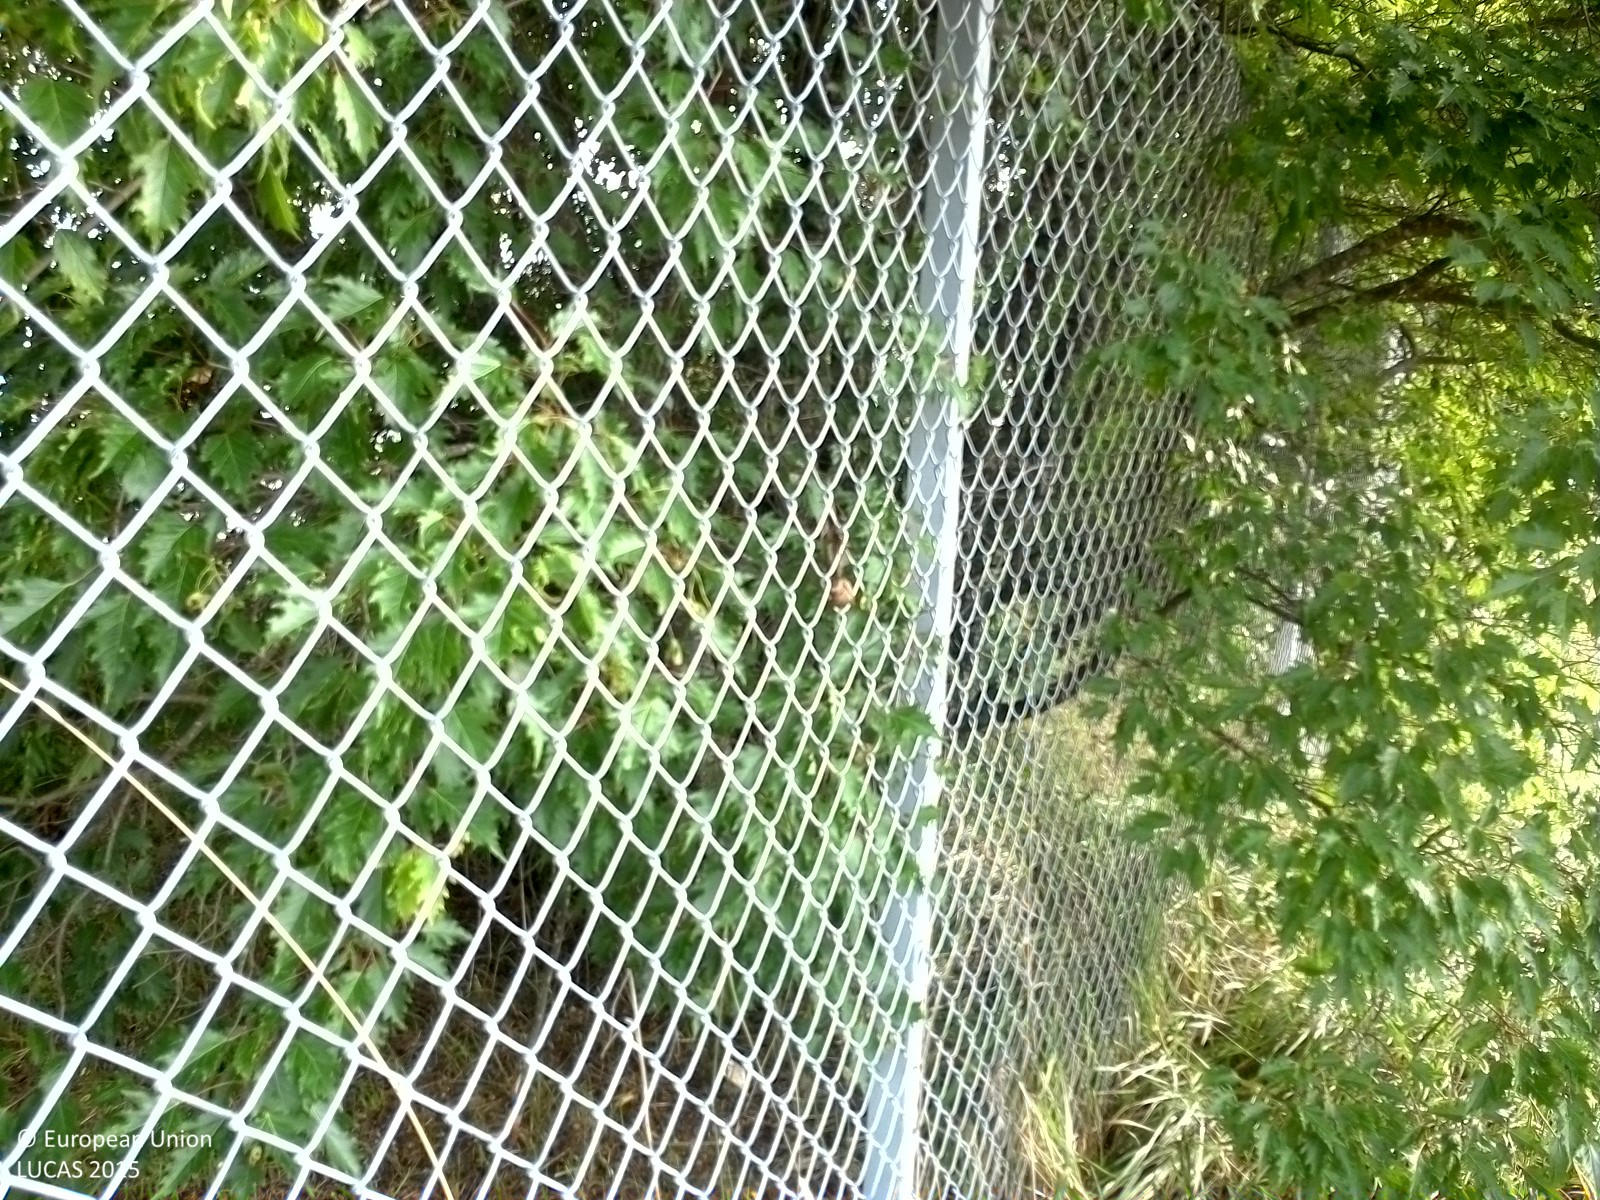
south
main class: Grassland
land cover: Grassland without tree/shrub cover
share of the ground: > 75 %
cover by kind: herbaceous plants 100 %
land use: Abandoned areas
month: August
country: SE
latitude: 62.4021
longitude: 17.2362
